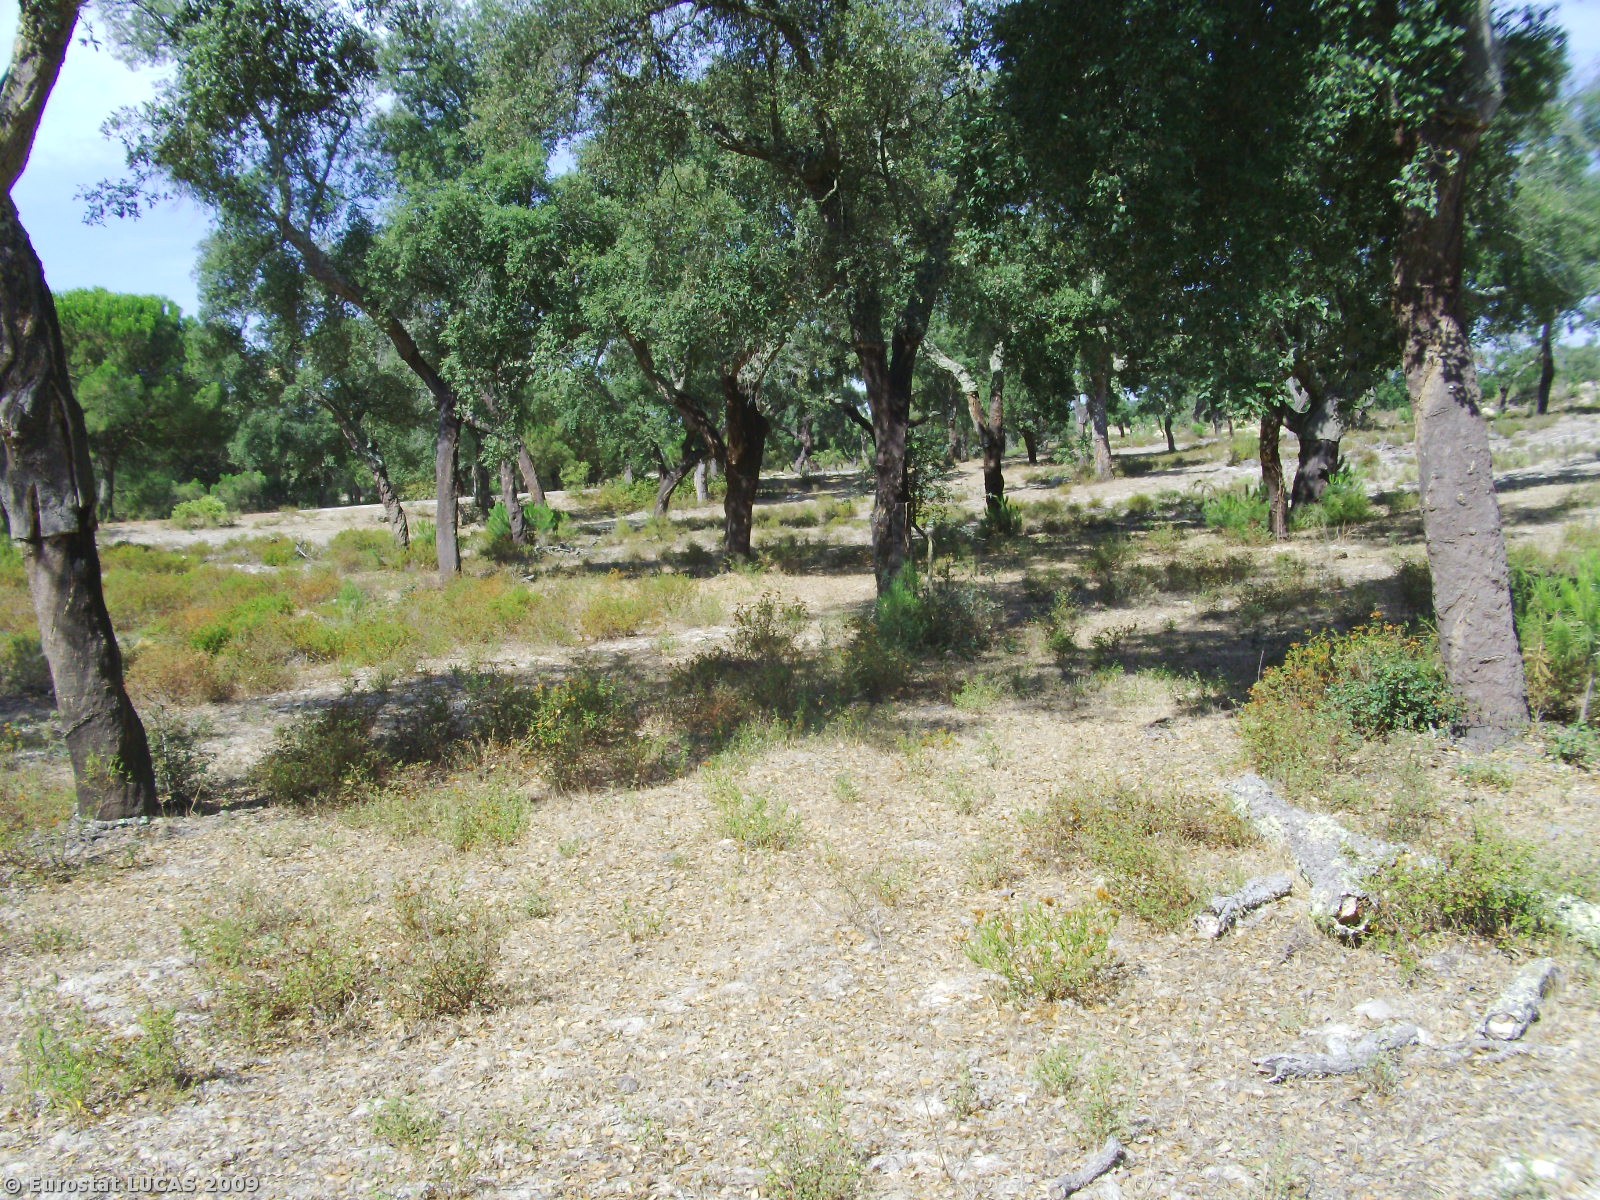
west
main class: Woodland
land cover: Broadleaved woodland
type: broadleaved evergreen forest
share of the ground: 25 - 50 %
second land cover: Spontaneously vegetated surfaces
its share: 50 - 75 %
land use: Forestry
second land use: Fallow land
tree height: > 5 m
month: August
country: PT
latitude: 38.5694
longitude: -8.6637
